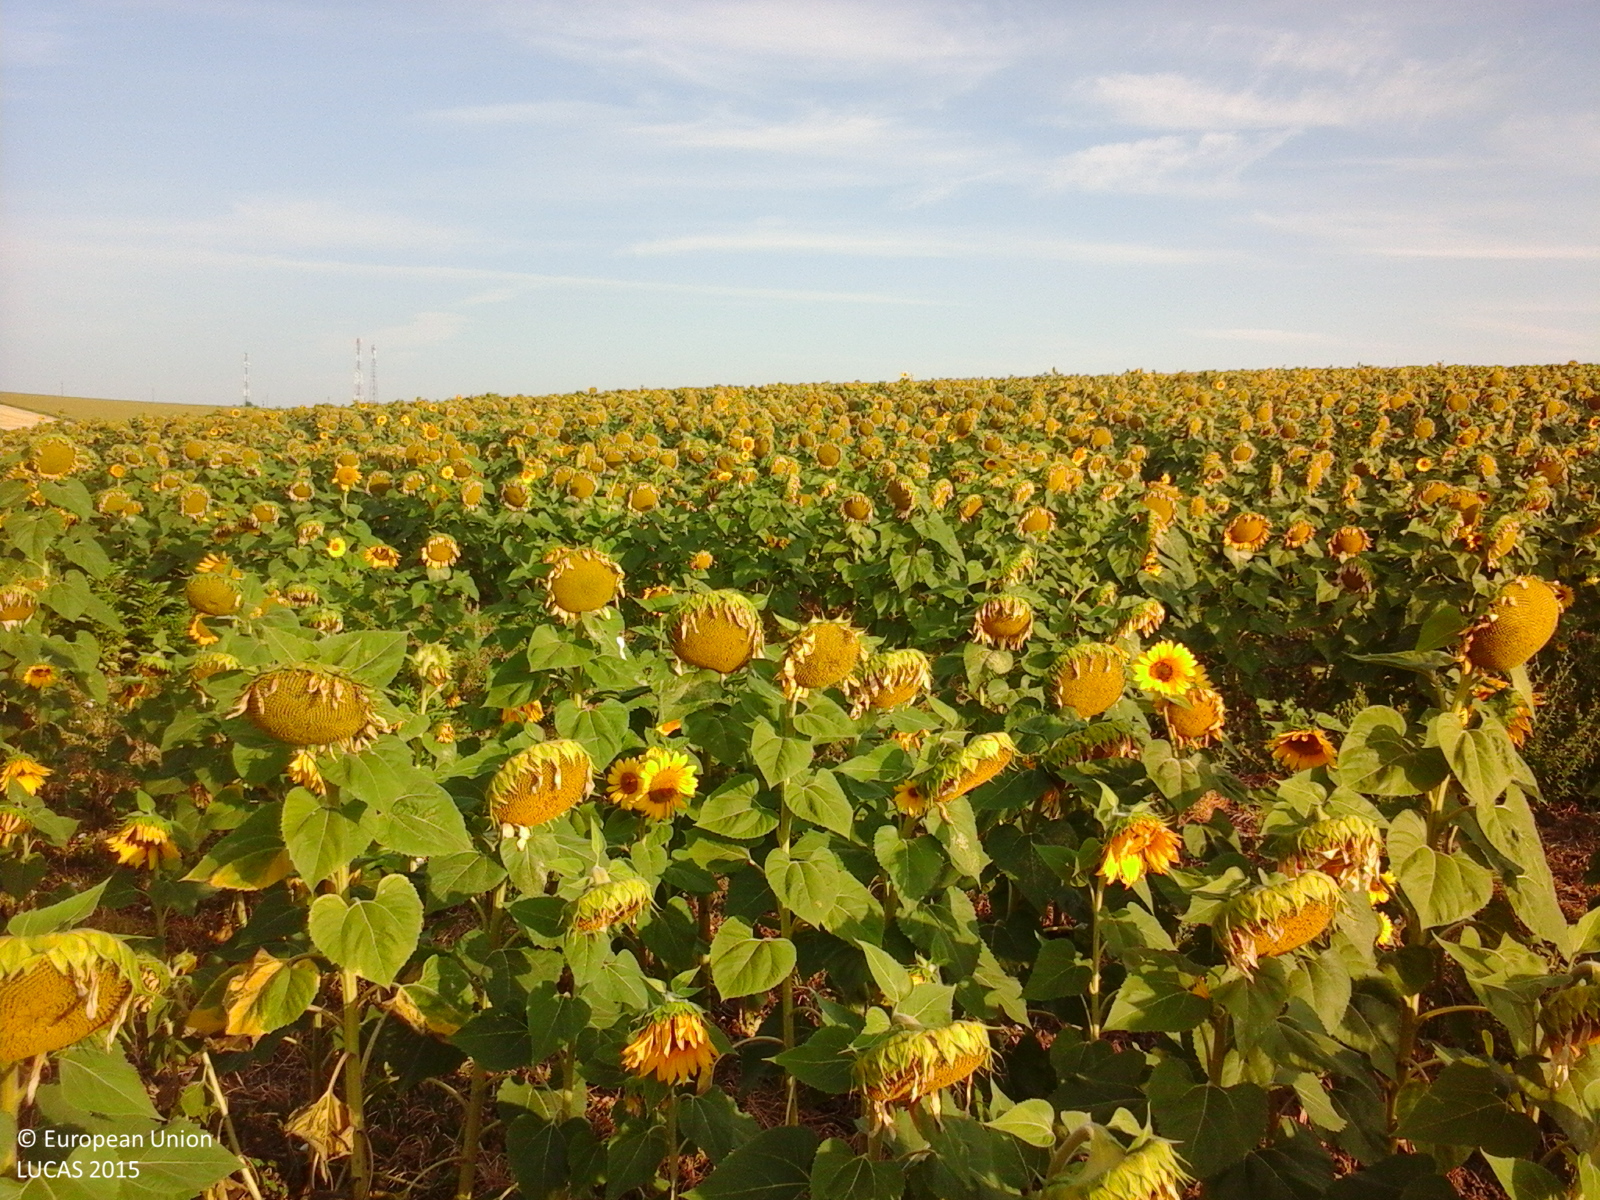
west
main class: Cropland
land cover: Sunflower
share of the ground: > 75 %
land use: Agriculture (excluding fallow land and kitchen gardens)
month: July
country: RO
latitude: 46.1964
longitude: 28.0736
